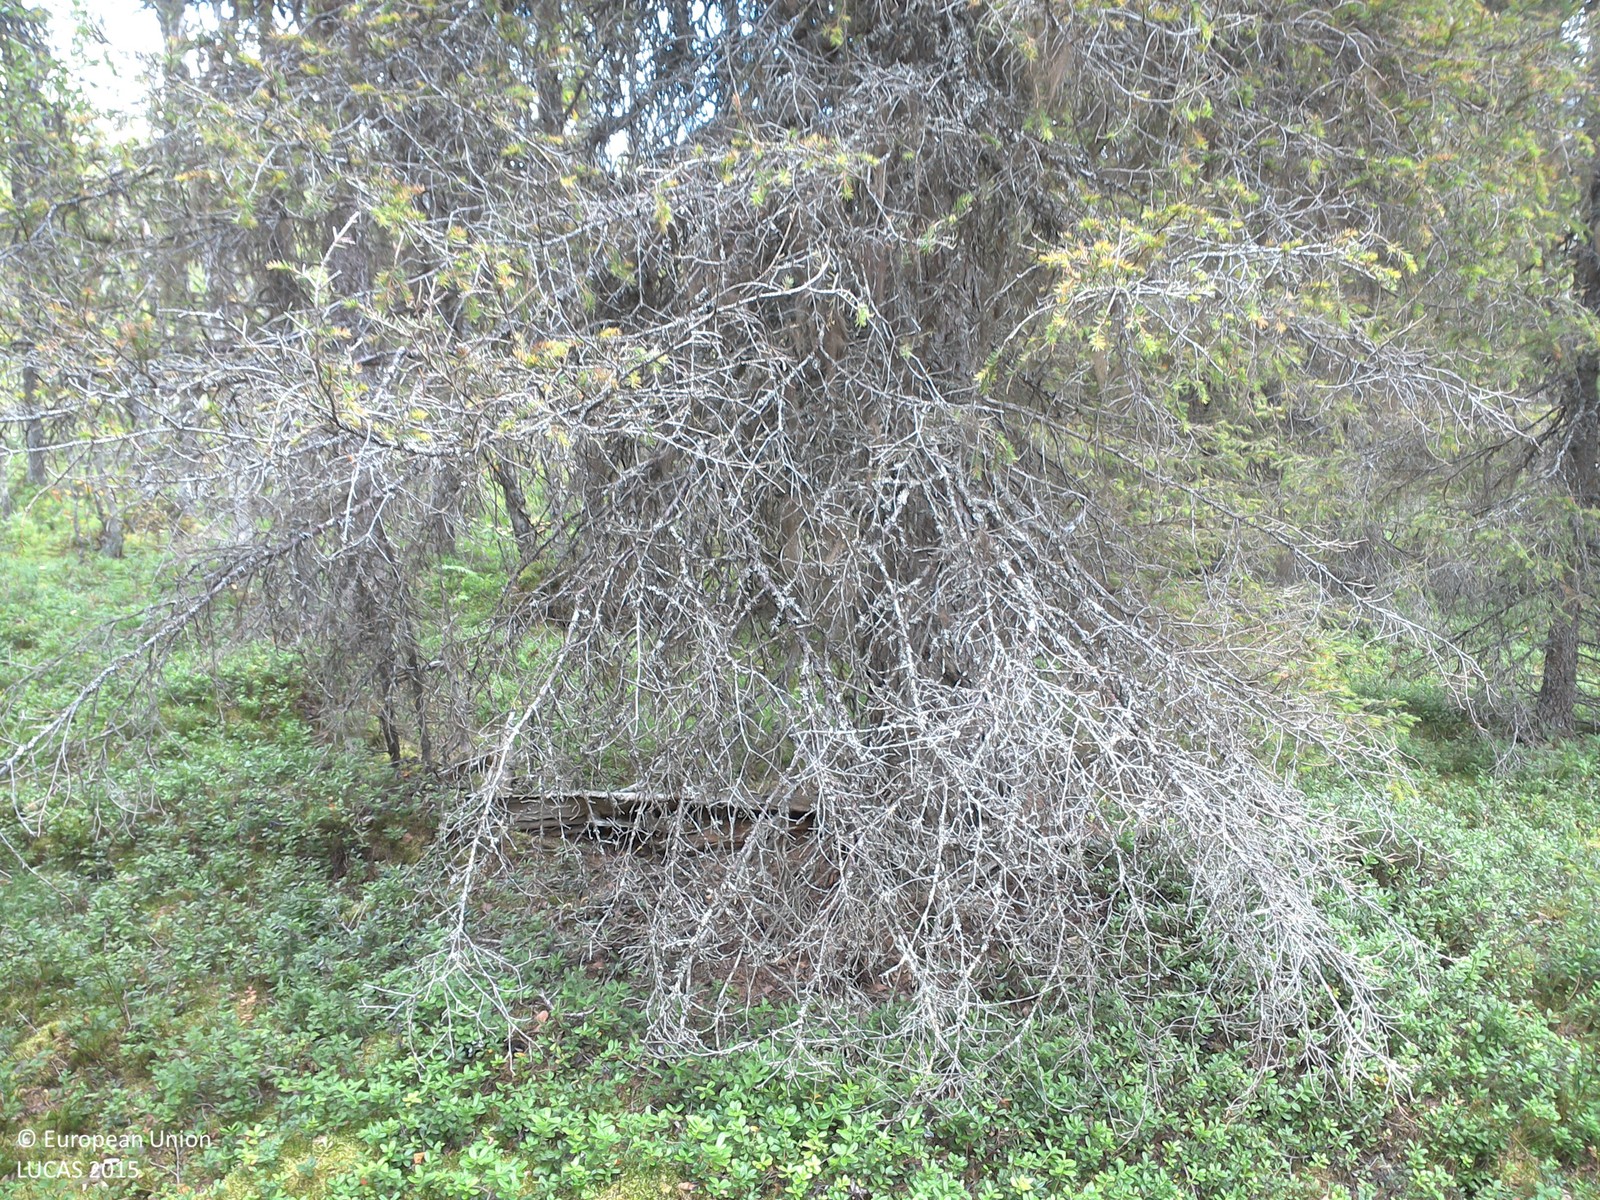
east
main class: Woodland
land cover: Spruce dominated mixed woodland
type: boreal forest
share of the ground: 25 - 50 %
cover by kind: shrubs 50 %, coniferous forest trees 25 %, lichens and mosses 15 %, broadleaved forest trees 10 %
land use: Forestry
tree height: > 5 m
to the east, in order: Spruce dominated mixed woodland; Pine dominated mixed woodland; Pine dominated coniferous woodland; Pine dominated mixed woodland
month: August
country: SE
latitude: 67.2824
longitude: 21.9524
